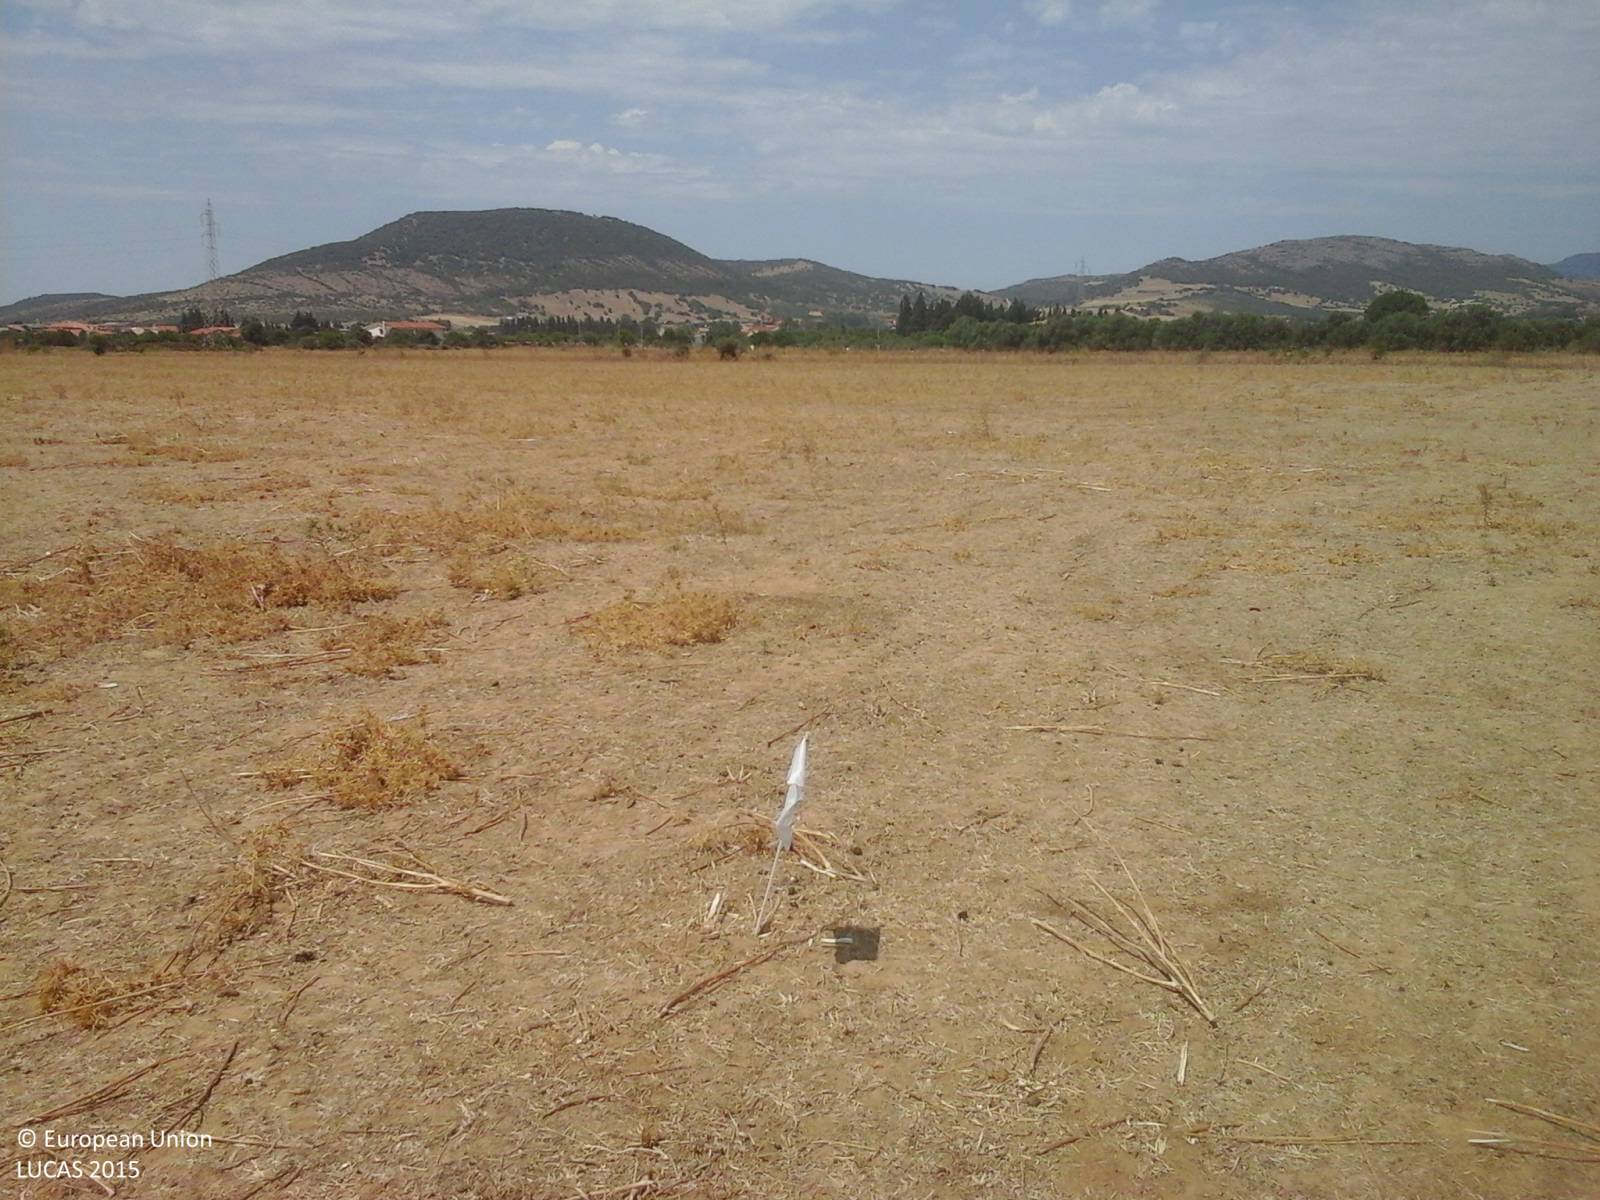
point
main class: Grassland
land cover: Grassland without tree/shrub cover
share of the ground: > 75 %
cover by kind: herbaceous plants 75 %, unconsolidated bare surface 20 %, consolidated bare surface 5 %
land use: Agriculture (excluding fallow land and kitchen gardens)
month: July
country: IT
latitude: 39.1172
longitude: 8.6783
